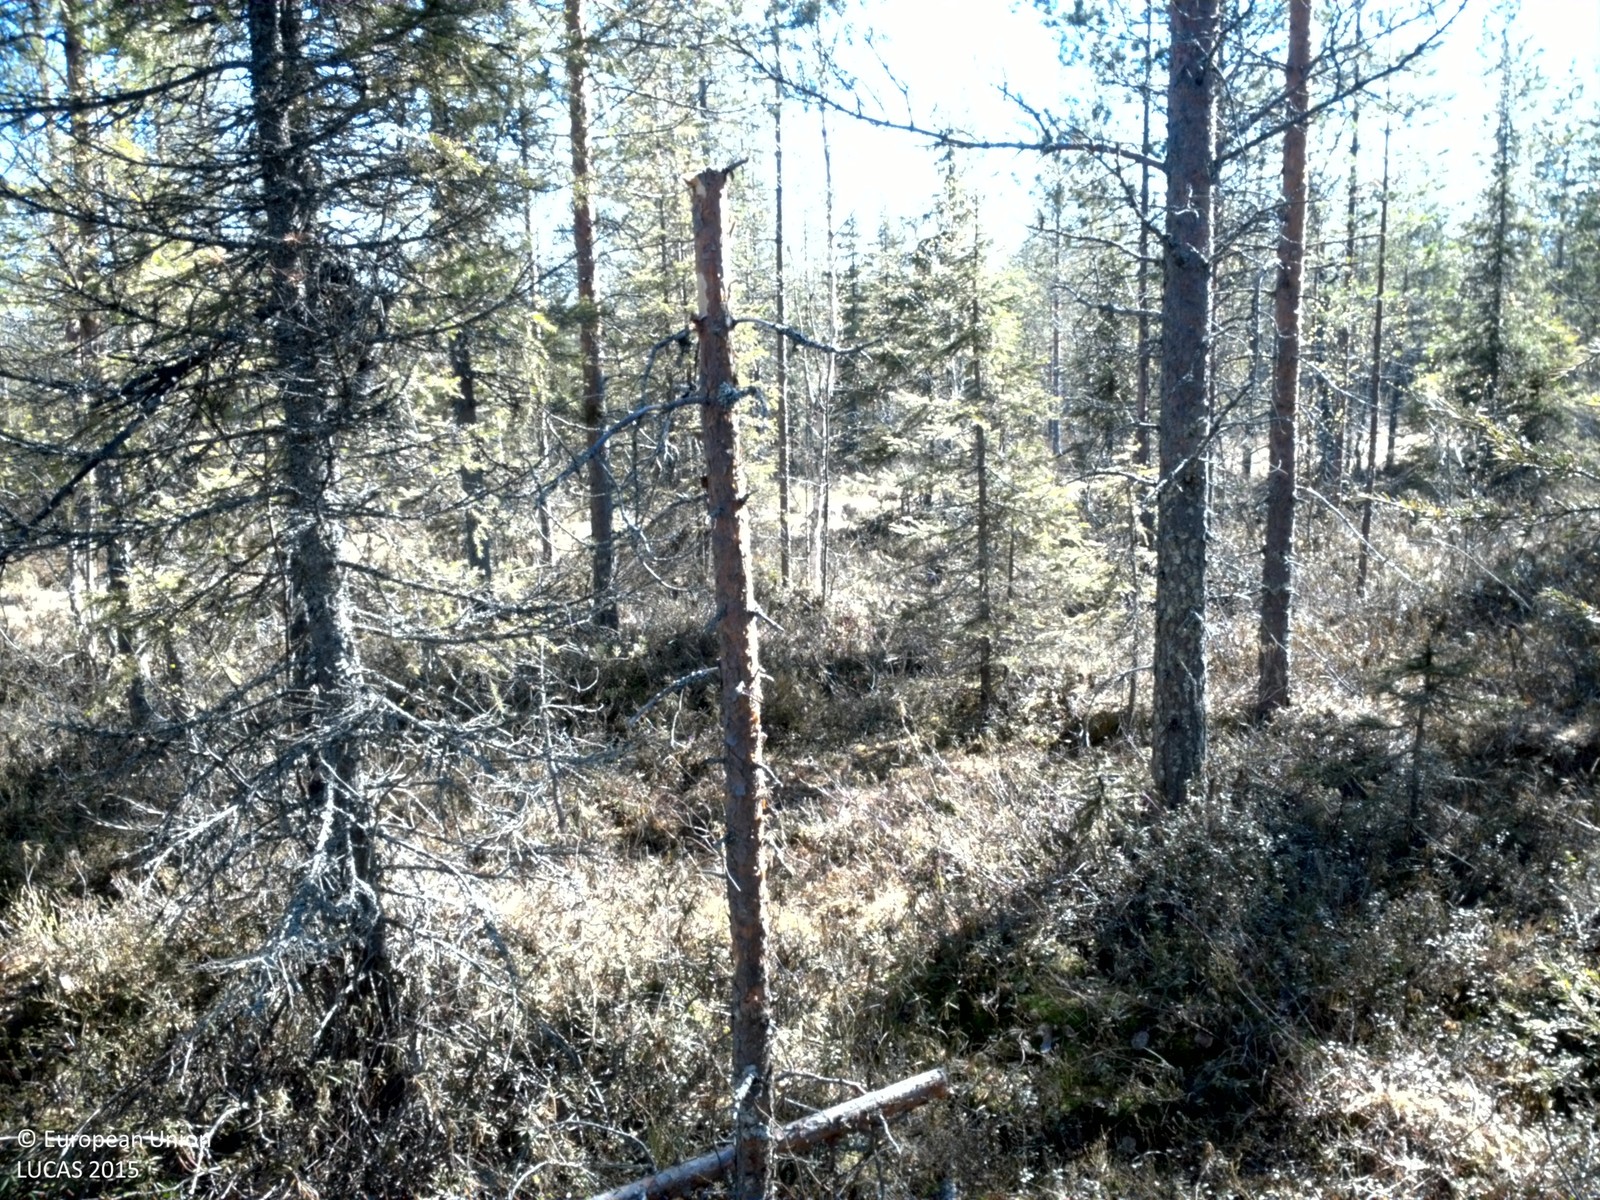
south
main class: Woodland
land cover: Other coniferous woodland
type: boreal forest
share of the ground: > 75 %
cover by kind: coniferous forest trees 75 %, shrubs 20 %, broadleaved forest trees 5 %
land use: Forestry
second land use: Community services
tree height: > 5 m
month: May
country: SE
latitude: 66.1866
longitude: 23.1005
